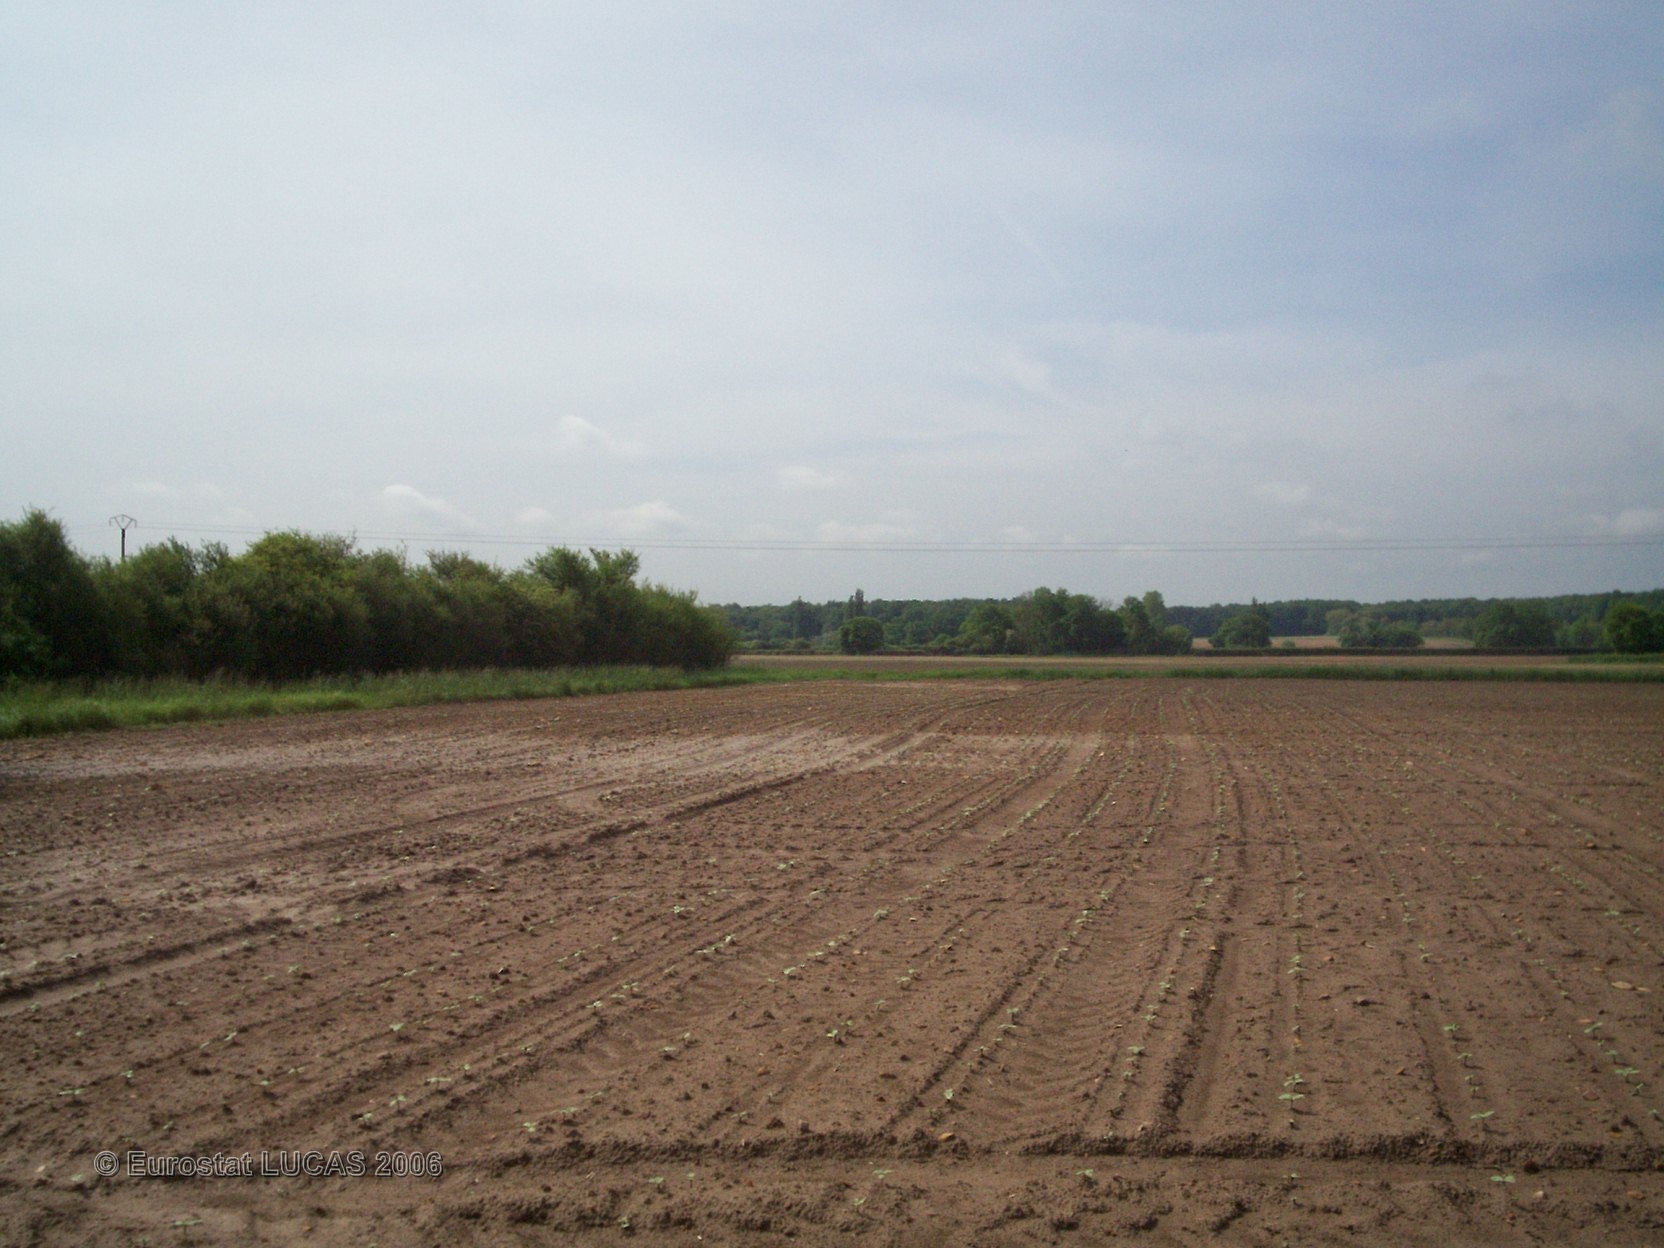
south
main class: Cropland
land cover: Sunflower
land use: Agriculture (excluding fallow land and kitchen gardens)
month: May
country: FR
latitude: 46.7445
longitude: 4.7263
